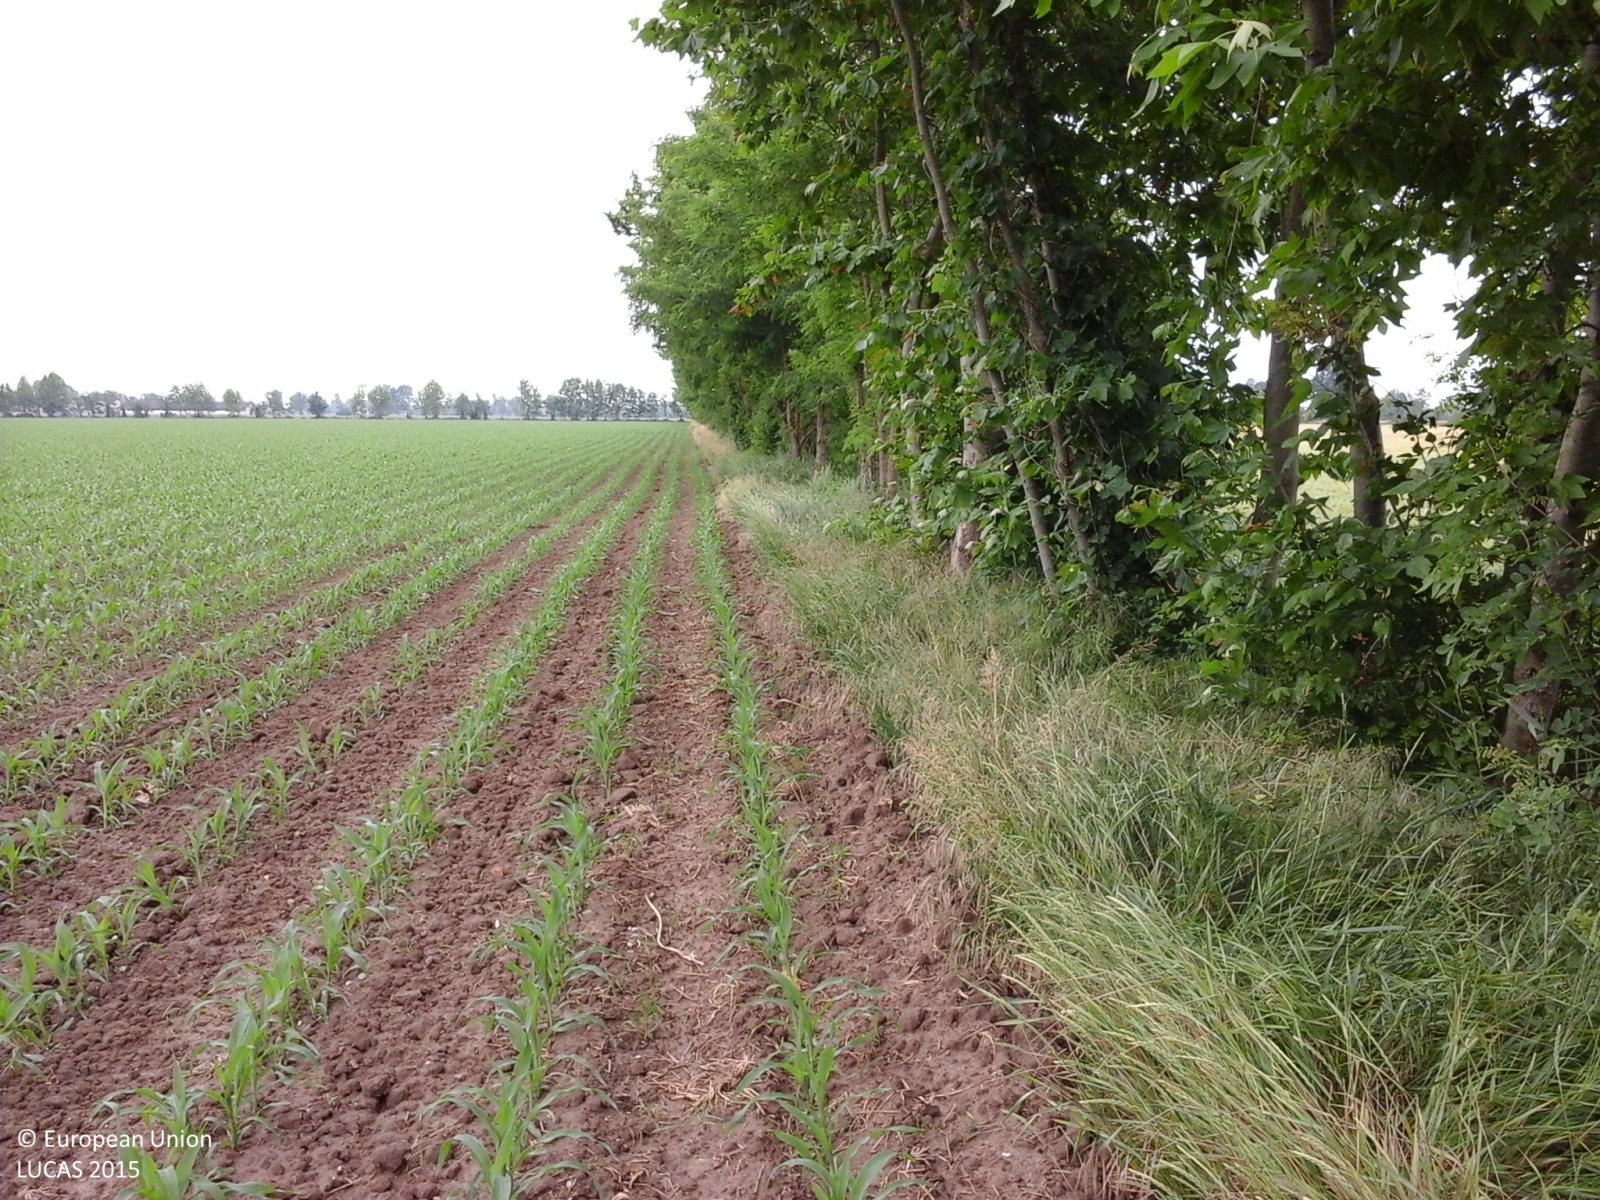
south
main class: Cropland
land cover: Barley
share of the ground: > 75 %
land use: Agriculture (excluding fallow land and kitchen gardens)
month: May
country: IT
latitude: 45.2698
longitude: 10.2672
